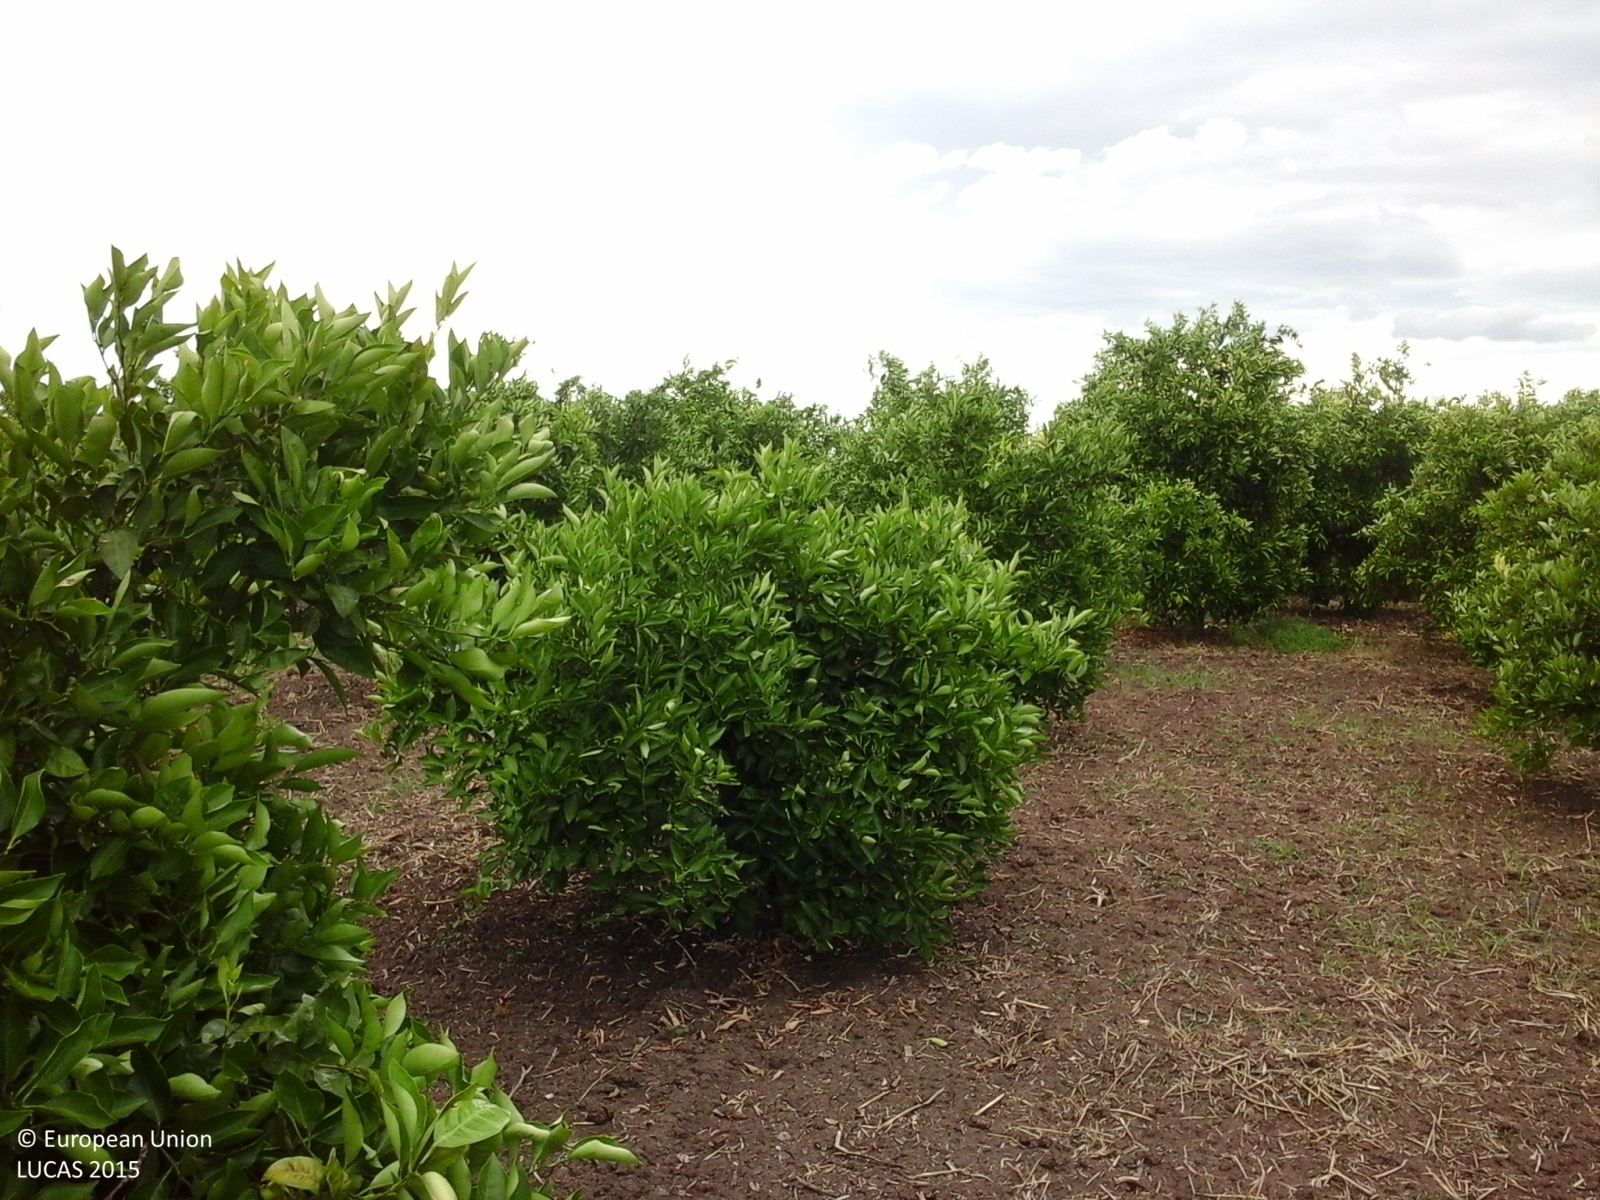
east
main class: Cropland
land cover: Oranges
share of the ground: > 75 %
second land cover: Spontaneously vegetated surfaces
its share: > 75 %
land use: Agriculture (excluding fallow land and kitchen gardens)
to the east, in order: Oranges; Spontaneously vegetated surfaces; Grass margins; Ditches and canals; Grass margins; Olive groves; Tracks; Olive groves
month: June
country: IT
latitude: 37.4970
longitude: 14.8399
